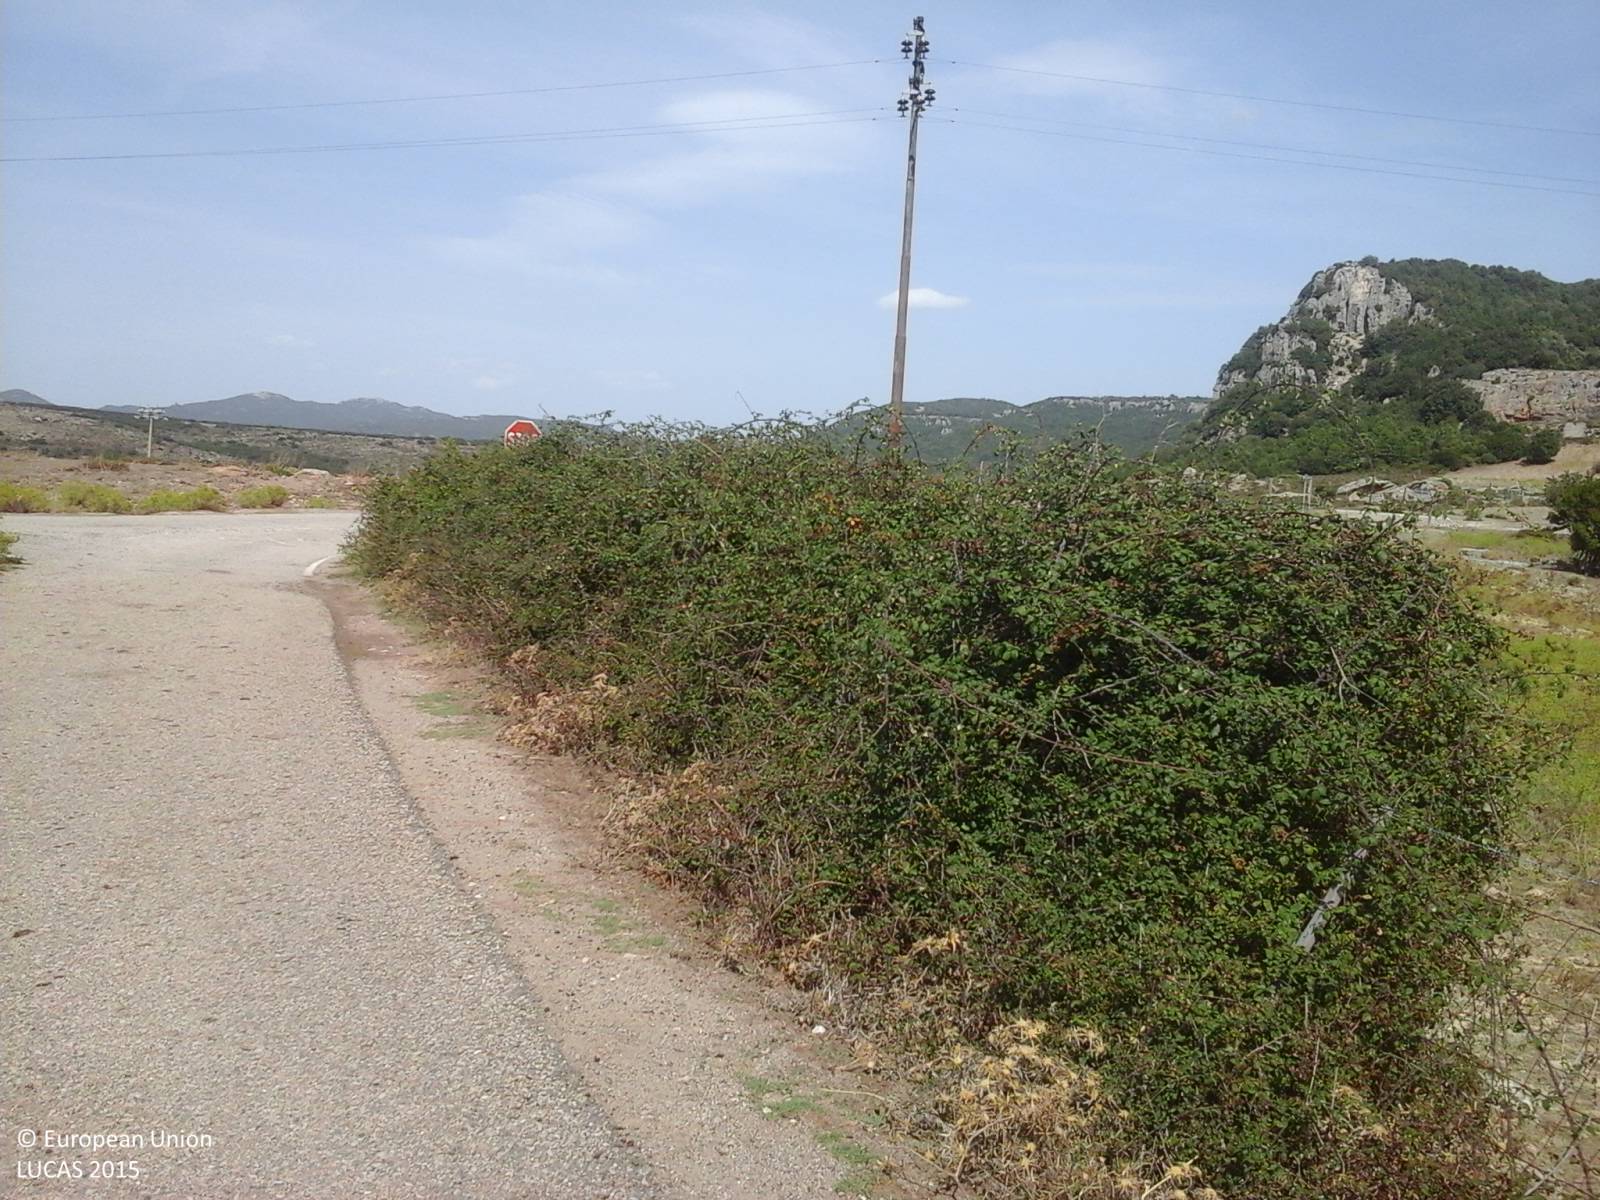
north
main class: Grassland
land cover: Grassland without tree/shrub cover
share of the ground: > 75 %
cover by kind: unconsolidated bare surface 40 %, herbaceous plants 35 %, consolidated bare surface 25 %
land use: Agriculture (excluding fallow land and kitchen gardens)
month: September
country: IT
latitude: 39.8126
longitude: 9.3611
